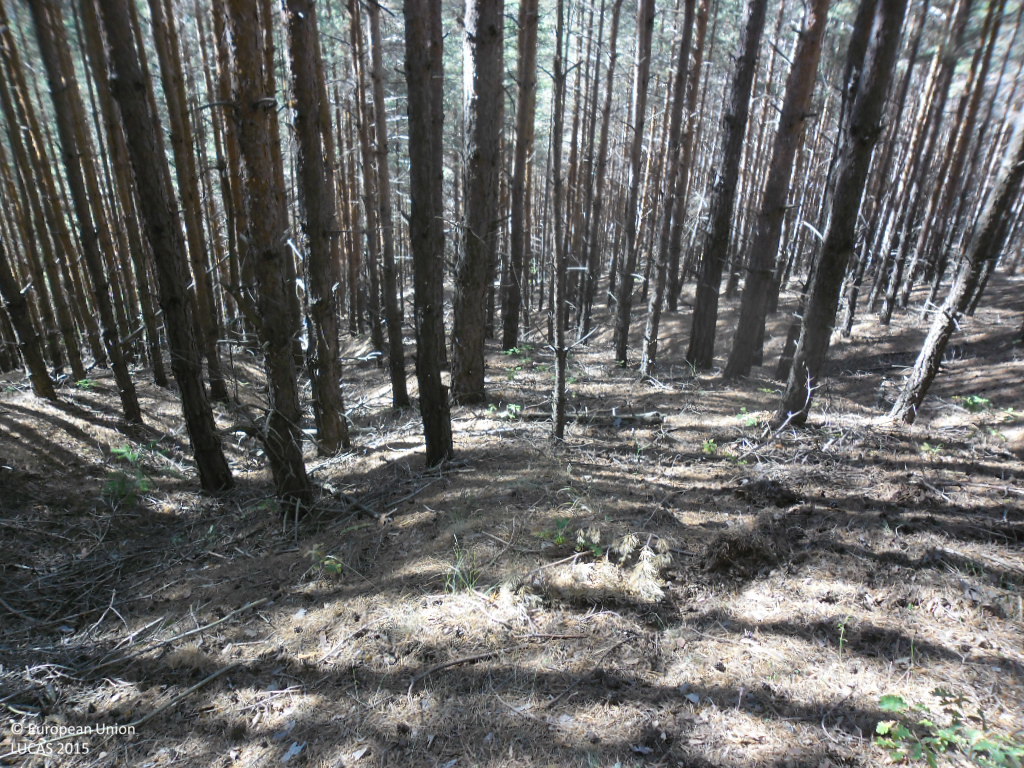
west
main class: Woodland
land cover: Pine dominated coniferous woodland
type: hemiboreal forest and nemoral coniferous forest and mixed broadleaved-coniferous forest
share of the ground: > 75 %
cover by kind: coniferous forest trees 95 %, unconsolidated bare surface 5 %
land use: Forestry
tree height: > 5 m
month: October
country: BG
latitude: 42.1140
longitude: 22.9278
